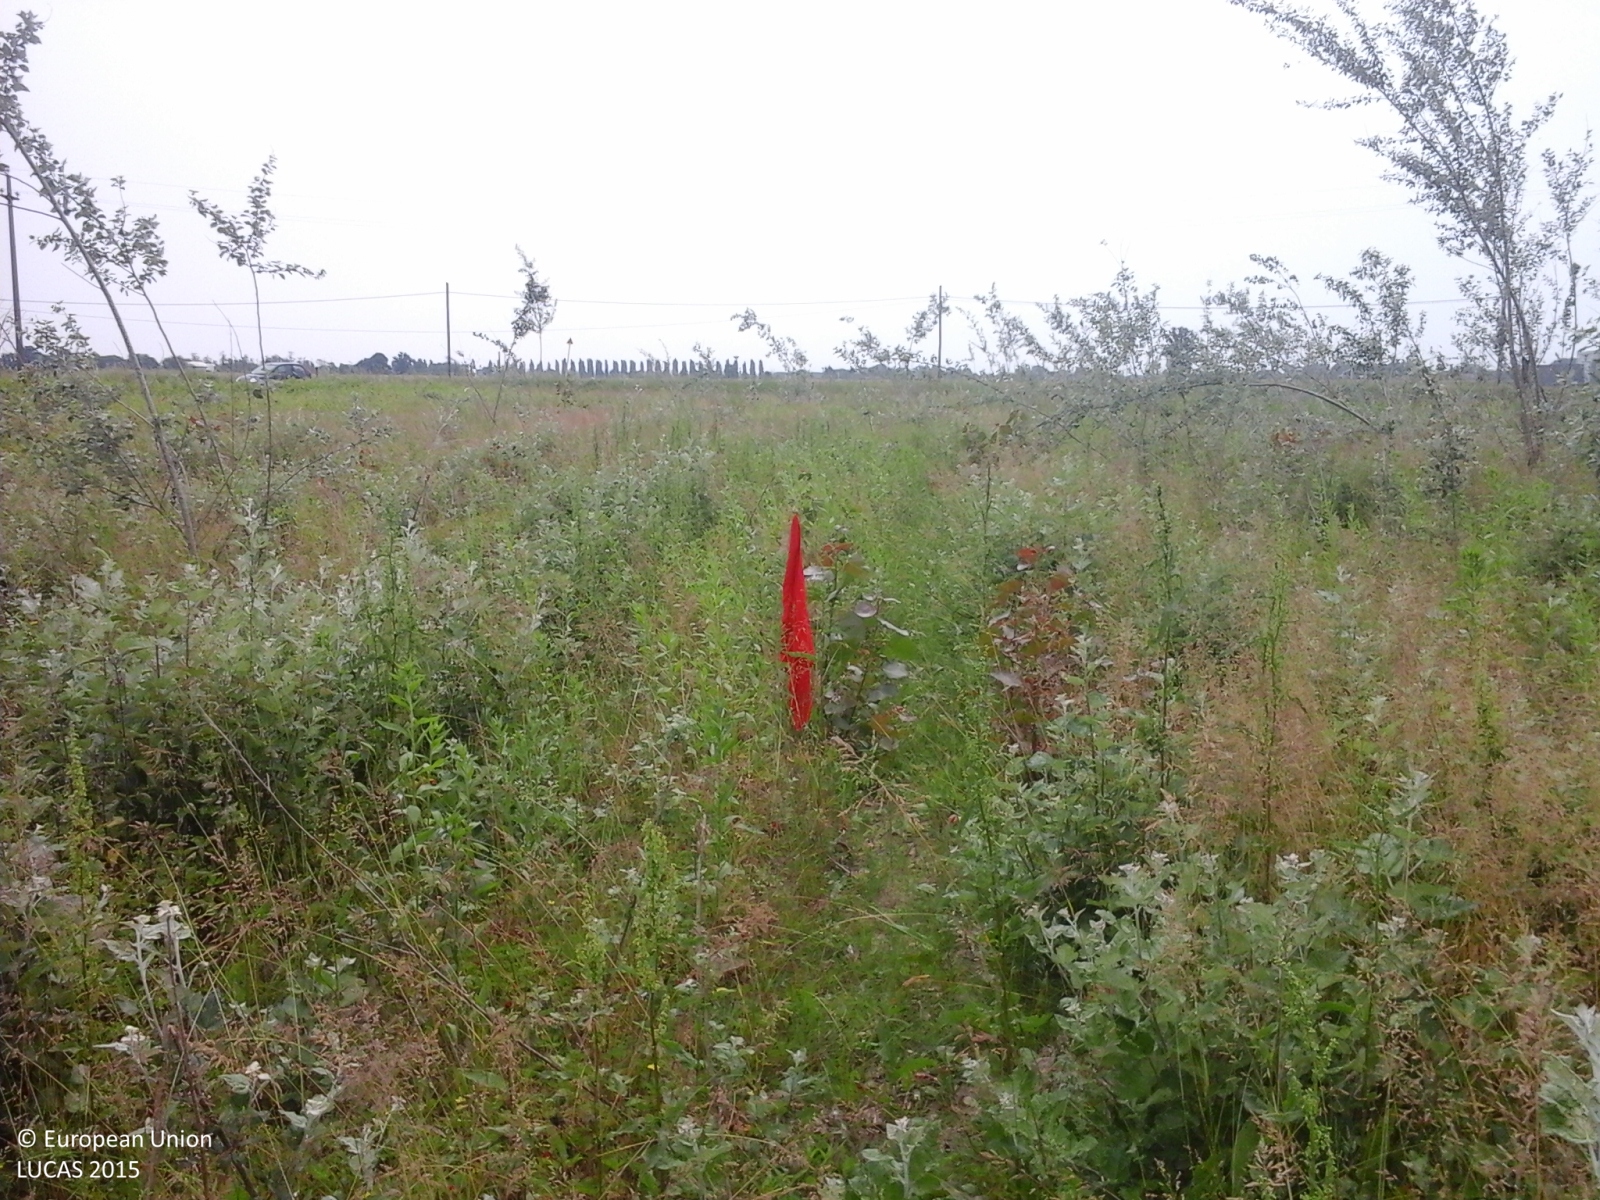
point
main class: Grassland
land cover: Grassland with sparse tree/shrub cover
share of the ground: > 75 %
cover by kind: herbaceous plants 90 %, broadleaved forest trees 5 %, shrubs 5 %
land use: Forestry
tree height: < 5 m
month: May
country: IT
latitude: 45.2863
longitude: 9.3764
